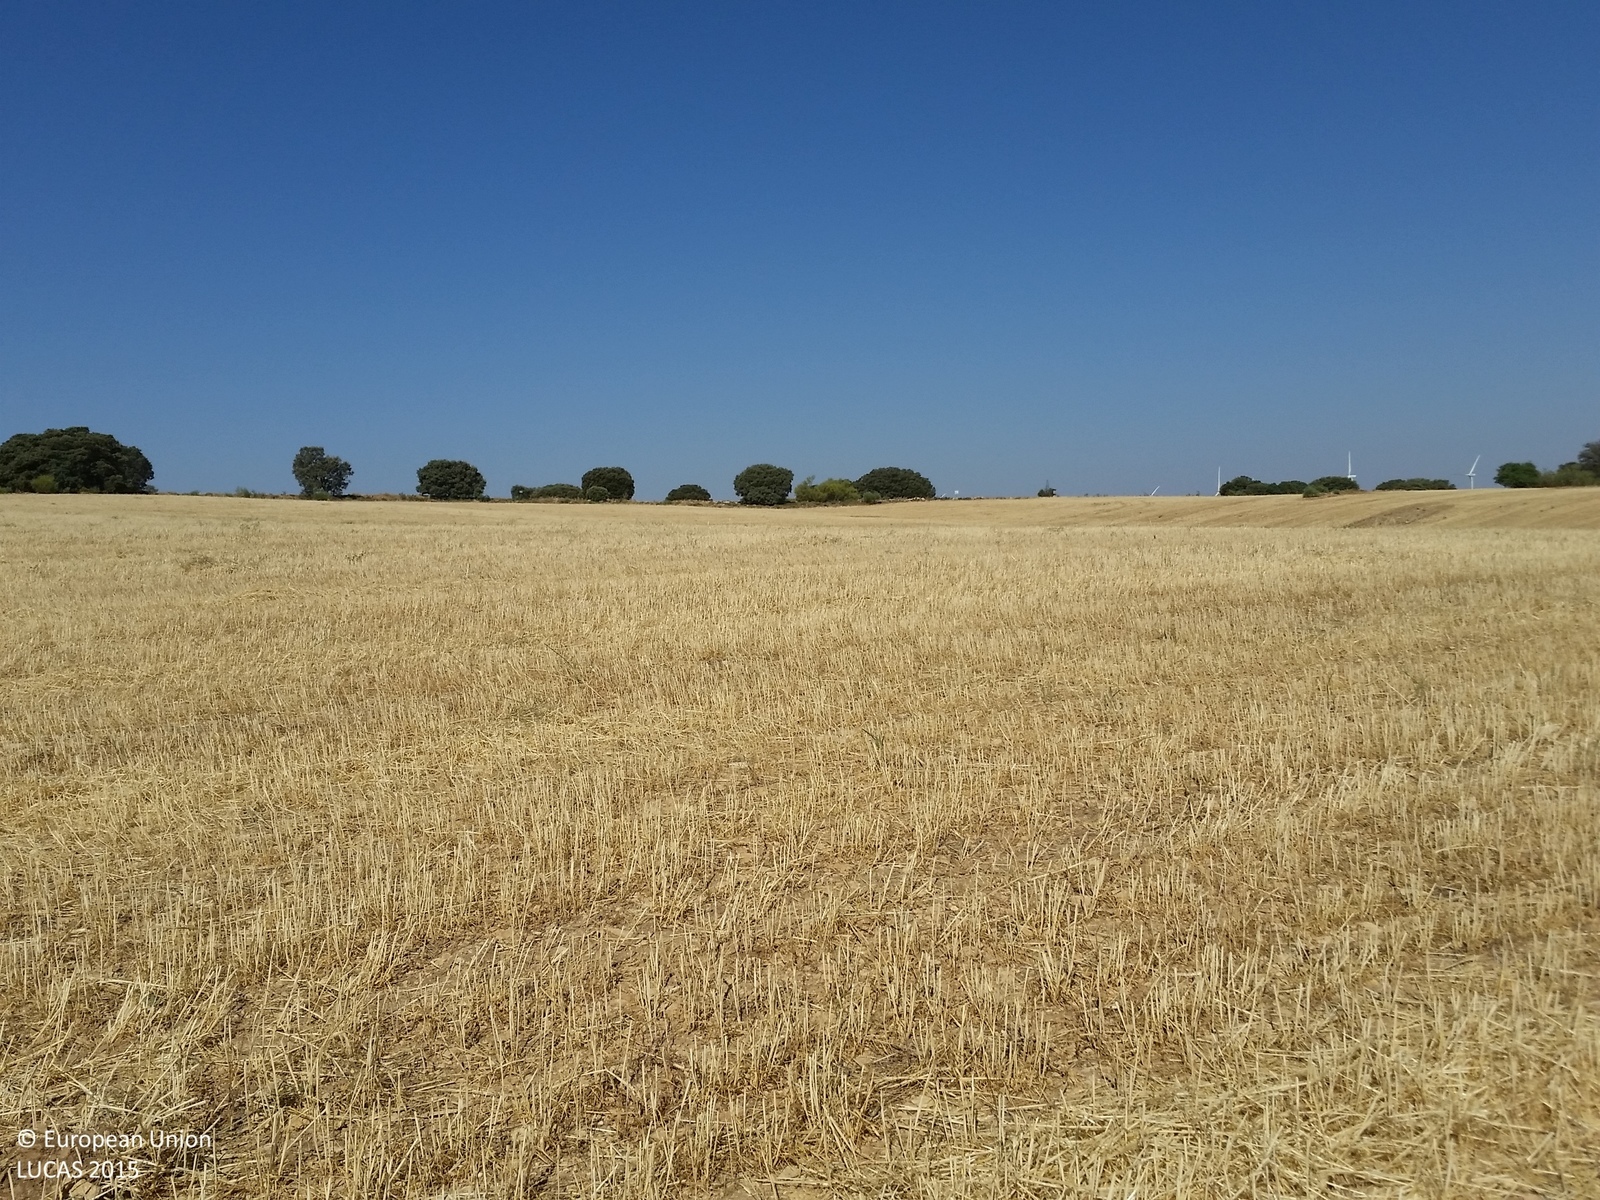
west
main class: Cropland
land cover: Barley
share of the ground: < 10 %
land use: Agriculture (excluding fallow land and kitchen gardens)
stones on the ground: 10 - 25 %
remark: Harvested field
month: July
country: ES
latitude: 39.0027
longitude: -2.5346
